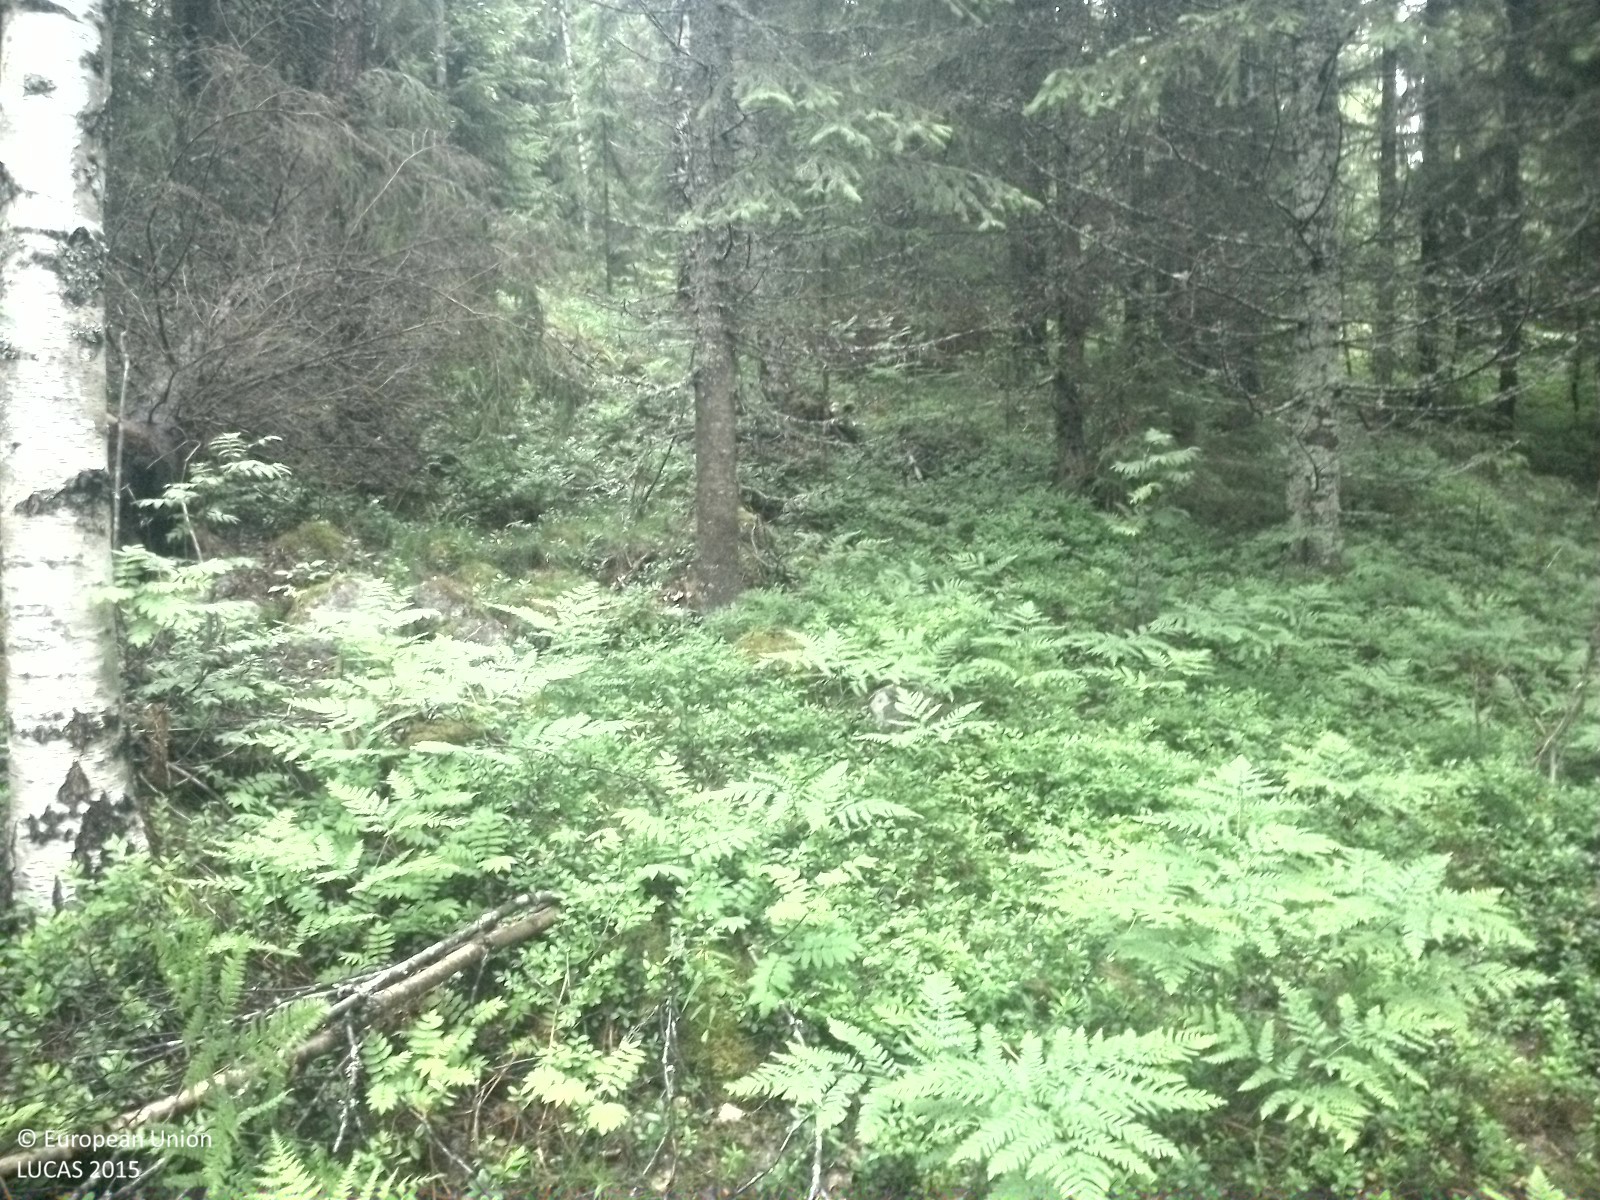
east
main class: Woodland
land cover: Spruce dominated mixed woodland
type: boreal forest
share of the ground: 50 - 75 %
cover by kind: coniferous forest trees 45 %, broadleaved forest trees 25 %, herbaceous plants 15 %, lichens and mosses 10 %, shrubs 5 %
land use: Forestry
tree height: > 5 m
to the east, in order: Spruce dominated mixed woodland
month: July
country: SE
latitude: 62.5491
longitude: 17.1933
